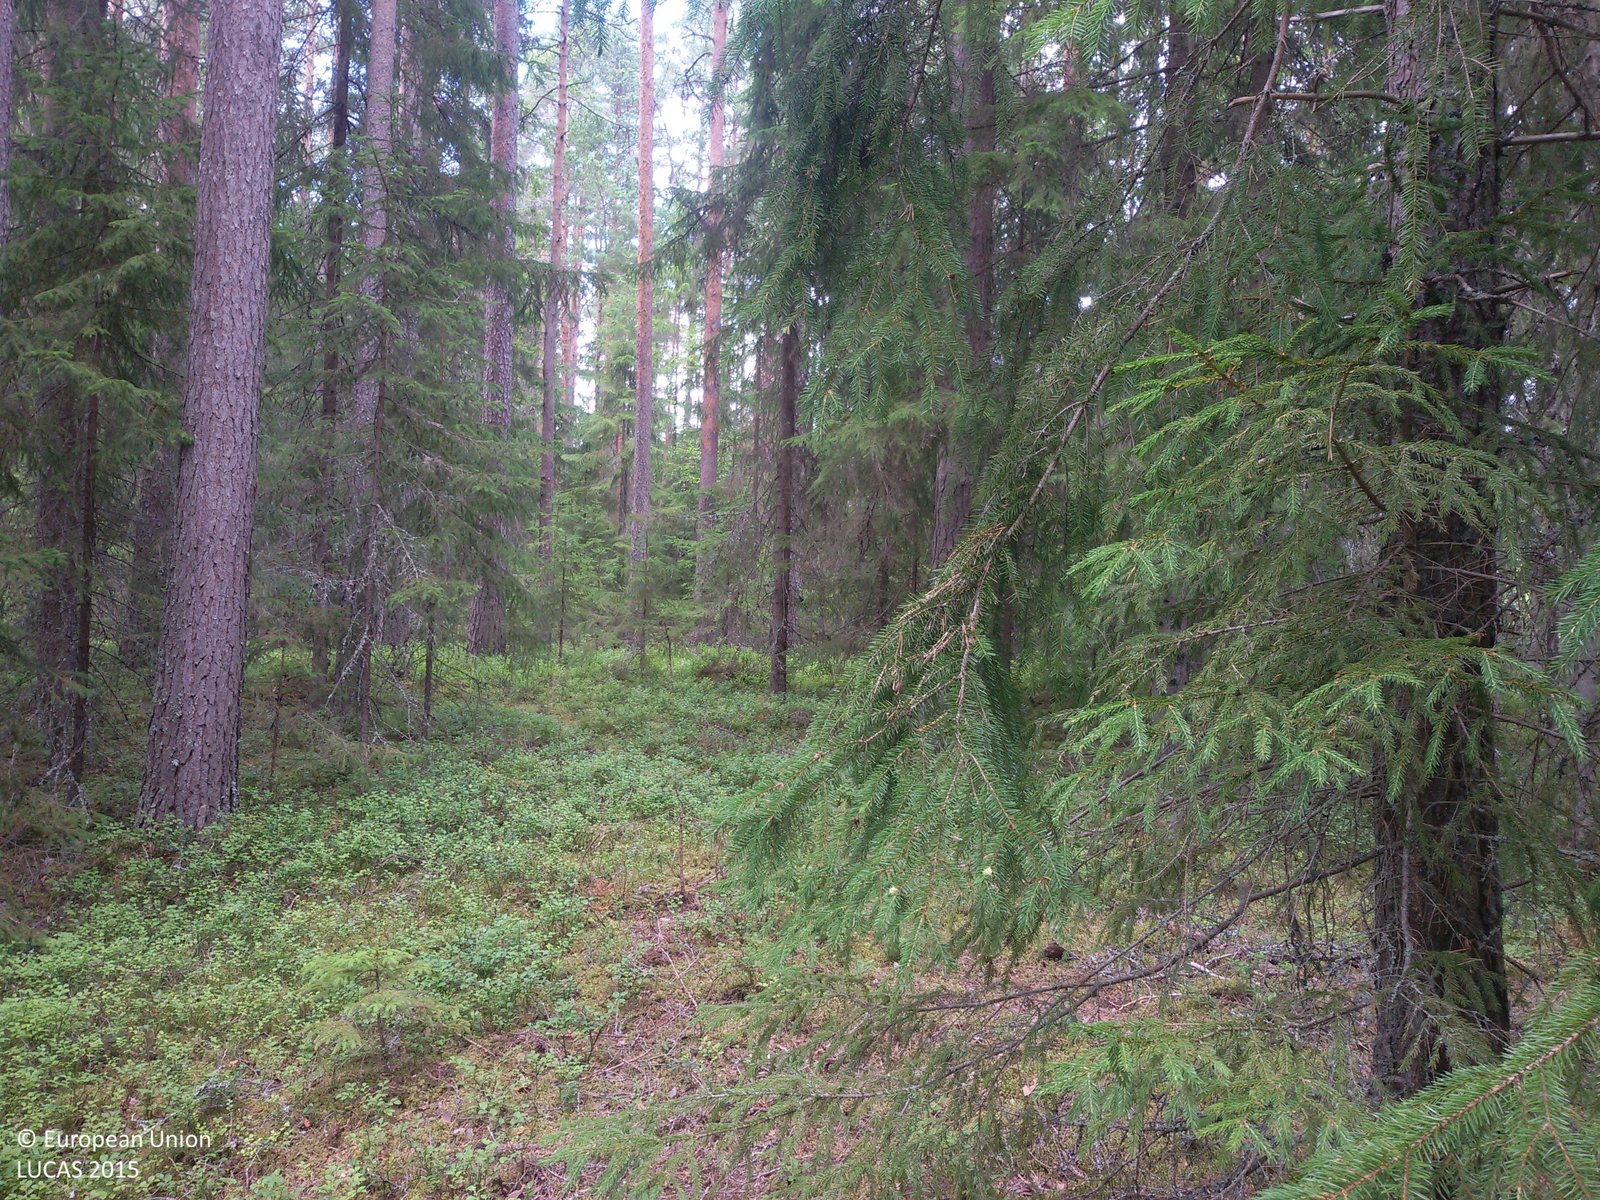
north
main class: Woodland
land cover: Spruce dominated coniferous woodland
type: boreal forest
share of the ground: > 75 %
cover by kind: coniferous forest trees 80 %, broadleaved forest trees 10 %, lichens and mosses 10 %
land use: Forestry
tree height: > 5 m
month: July
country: SE
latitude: 60.5533
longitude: 15.2211
